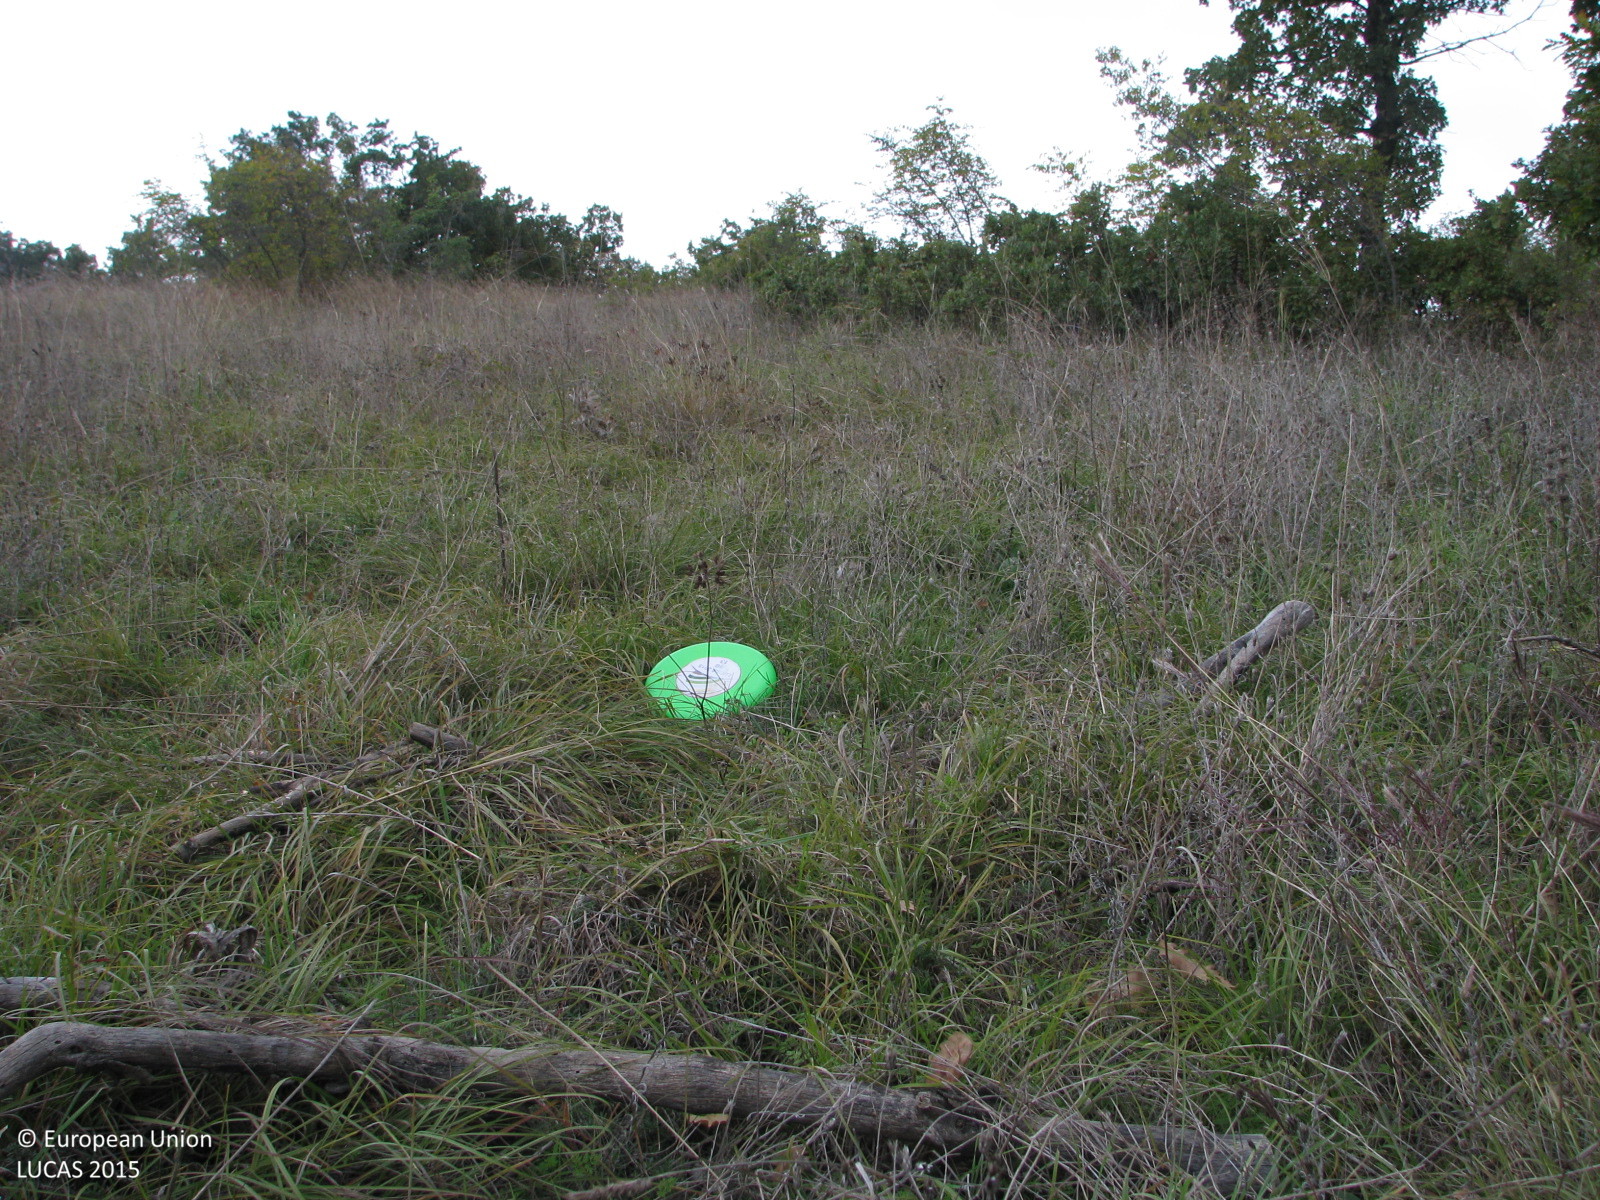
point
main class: Grassland
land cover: Grassland with sparse tree/shrub cover
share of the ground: > 75 %
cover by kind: herbaceous plants 85 %, shrubs 10 %, broadleaved forest trees 5 %
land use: Semi-natural and natural areas not in use
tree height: < 5 m
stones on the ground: < 10 %
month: October
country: BG
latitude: 41.9884
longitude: 26.6129
